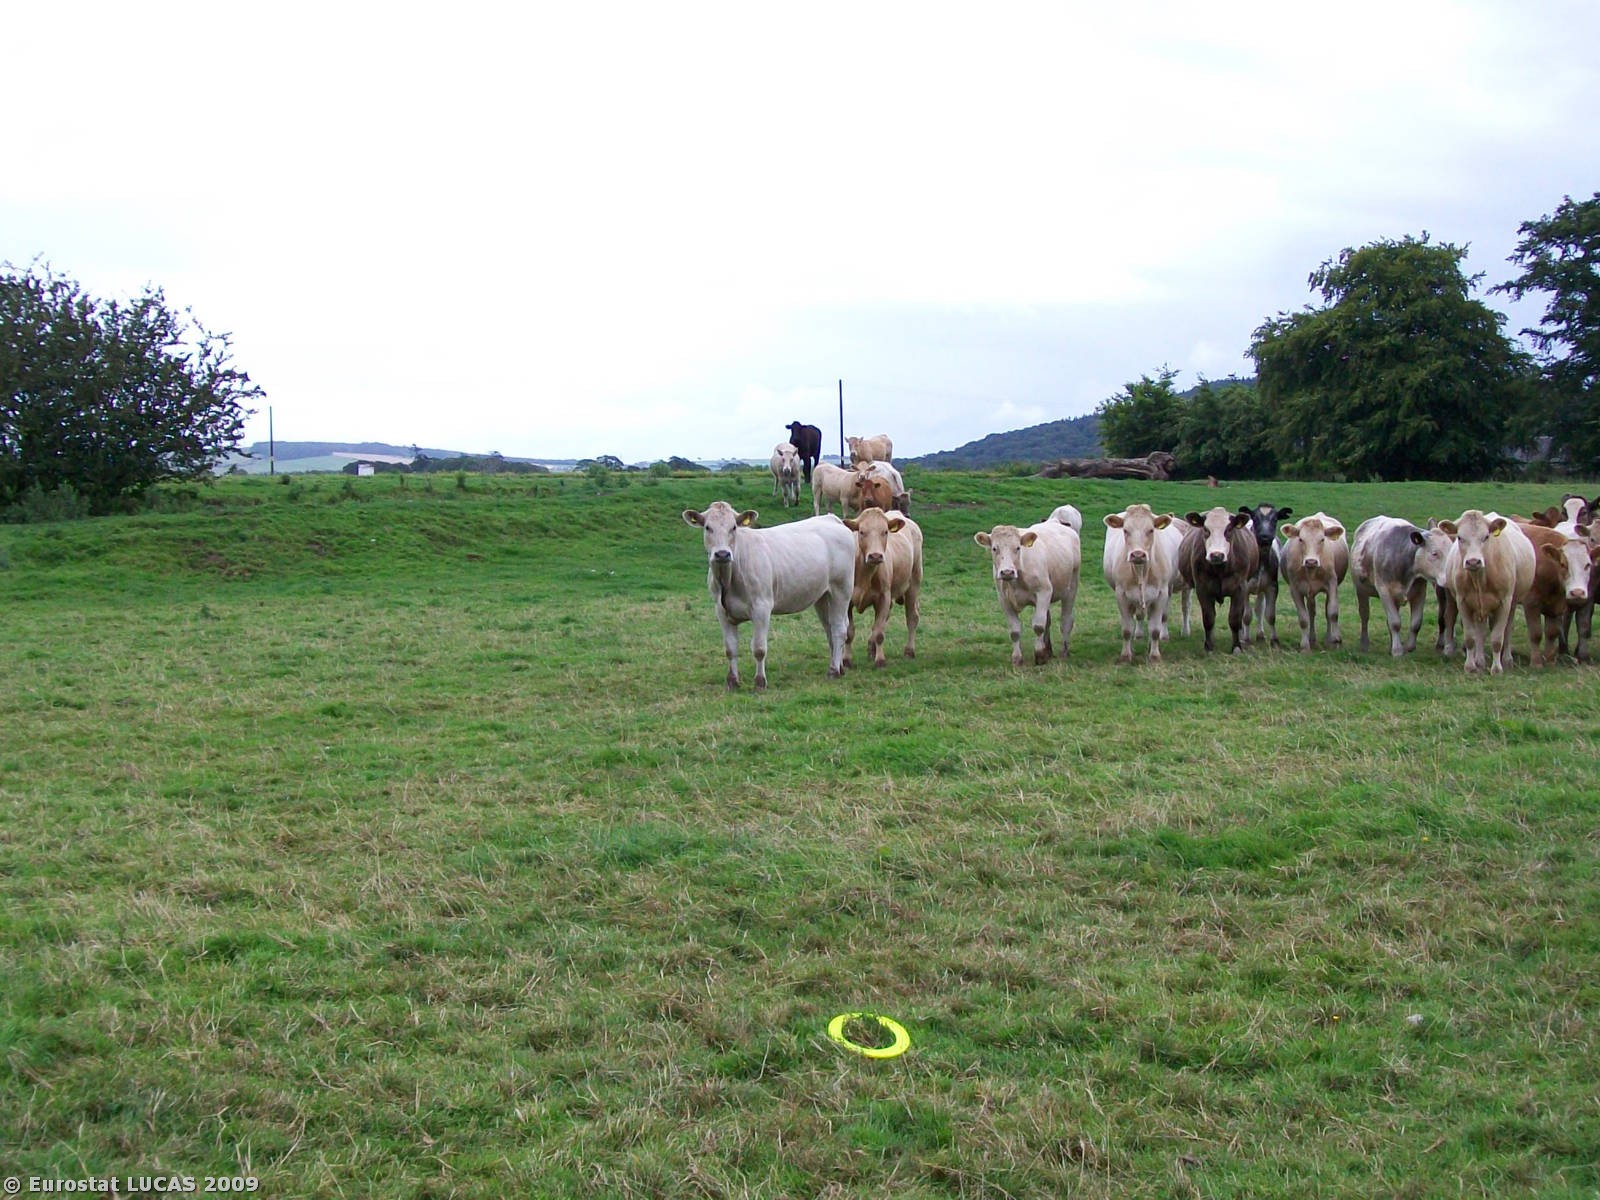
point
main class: Grassland
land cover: Grassland without tree/shrub cover
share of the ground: > 75 %
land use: Agriculture (excluding fallow land and kitchen gardens)
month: July
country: GB
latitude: 55.0496
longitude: -3.3348
